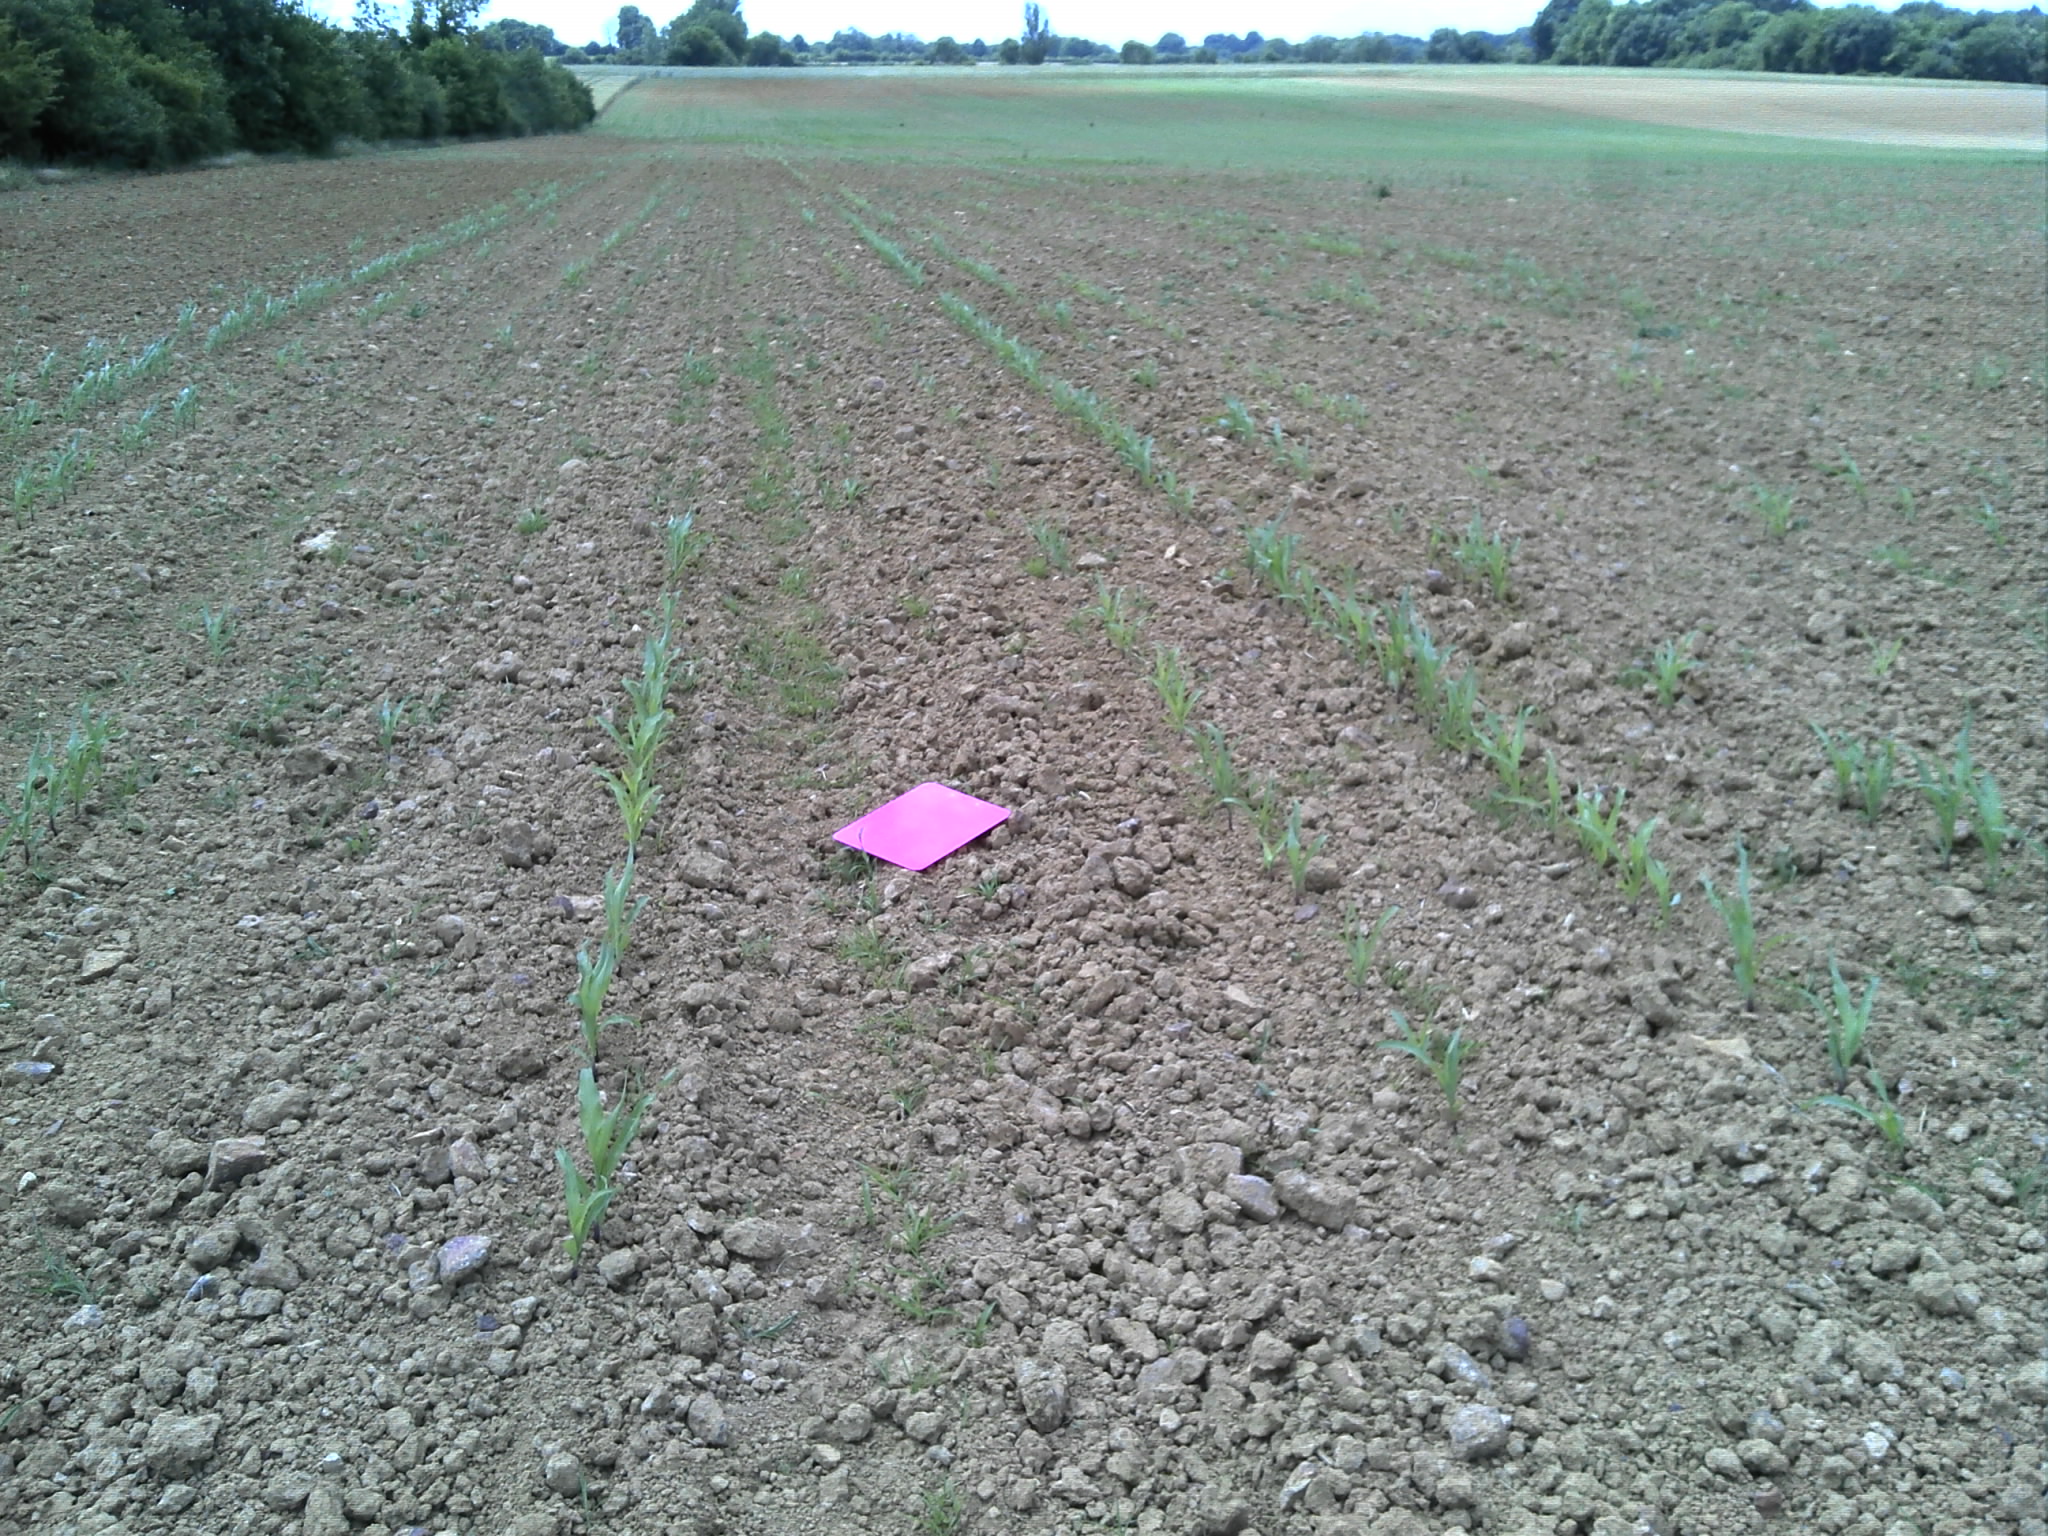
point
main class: Cropland
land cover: Maize
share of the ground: < 10 %
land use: Agriculture (excluding fallow land and kitchen gardens)
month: June
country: FR
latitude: 46.6001
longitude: 0.9390
